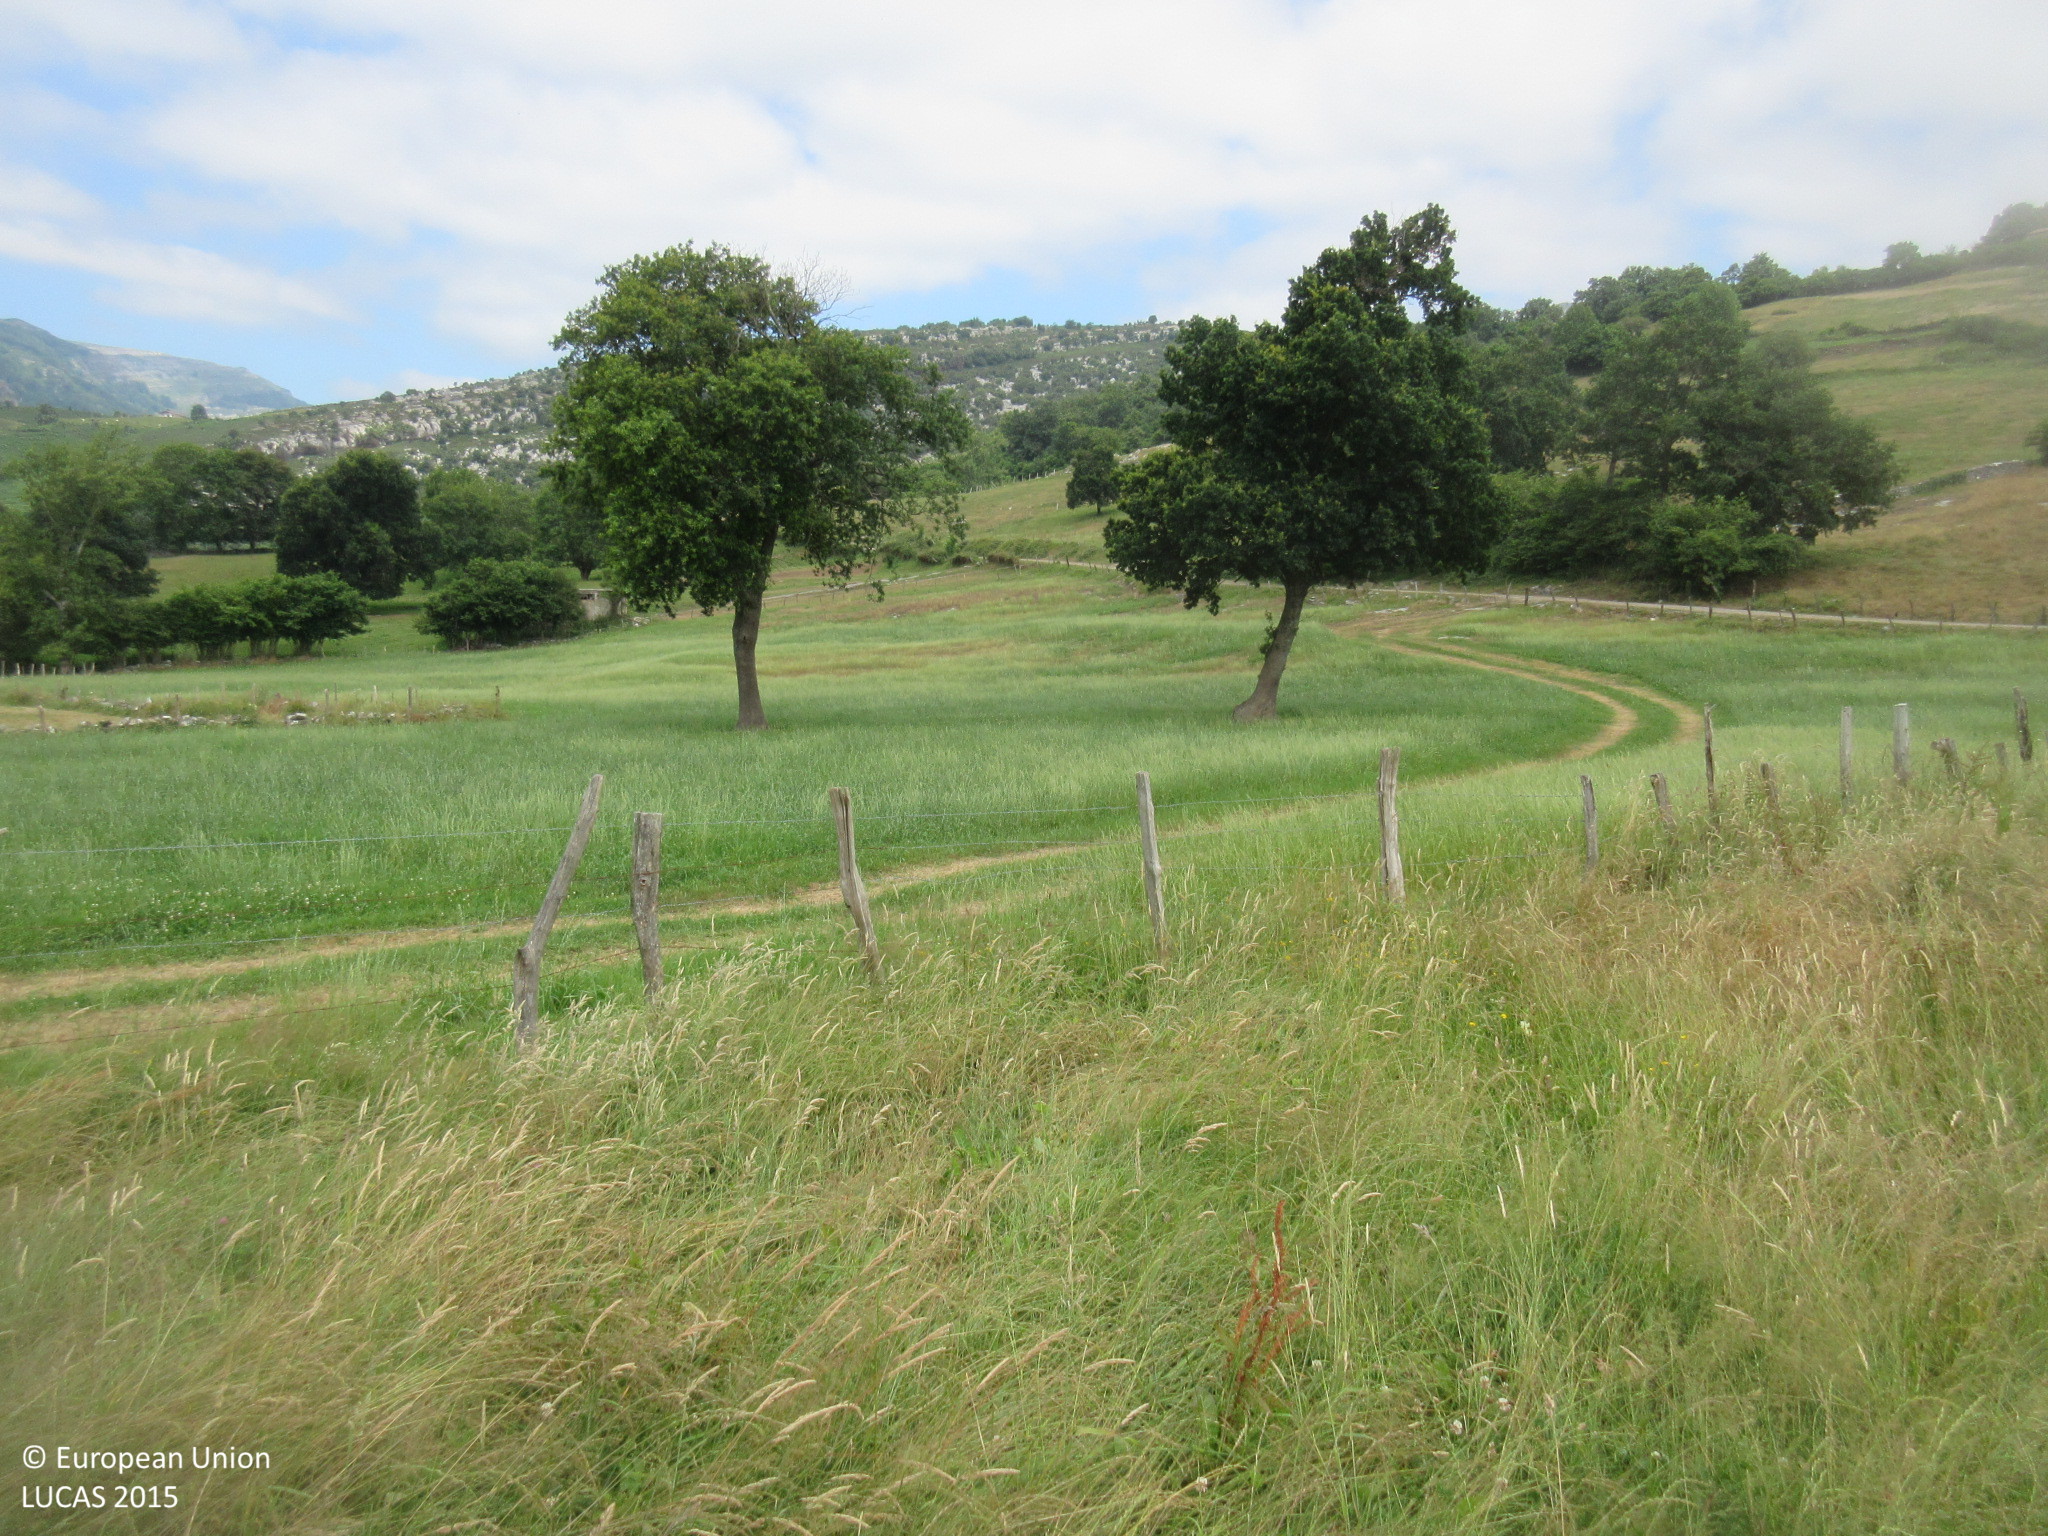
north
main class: Grassland
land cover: Grassland with sparse tree/shrub cover
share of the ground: > 75 %
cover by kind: herbaceous plants 95 %, broadleaved forest trees 5 %
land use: Agriculture (excluding fallow land and kitchen gardens)
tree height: > 5 m
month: July
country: ES
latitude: 43.1989
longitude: -3.5677
